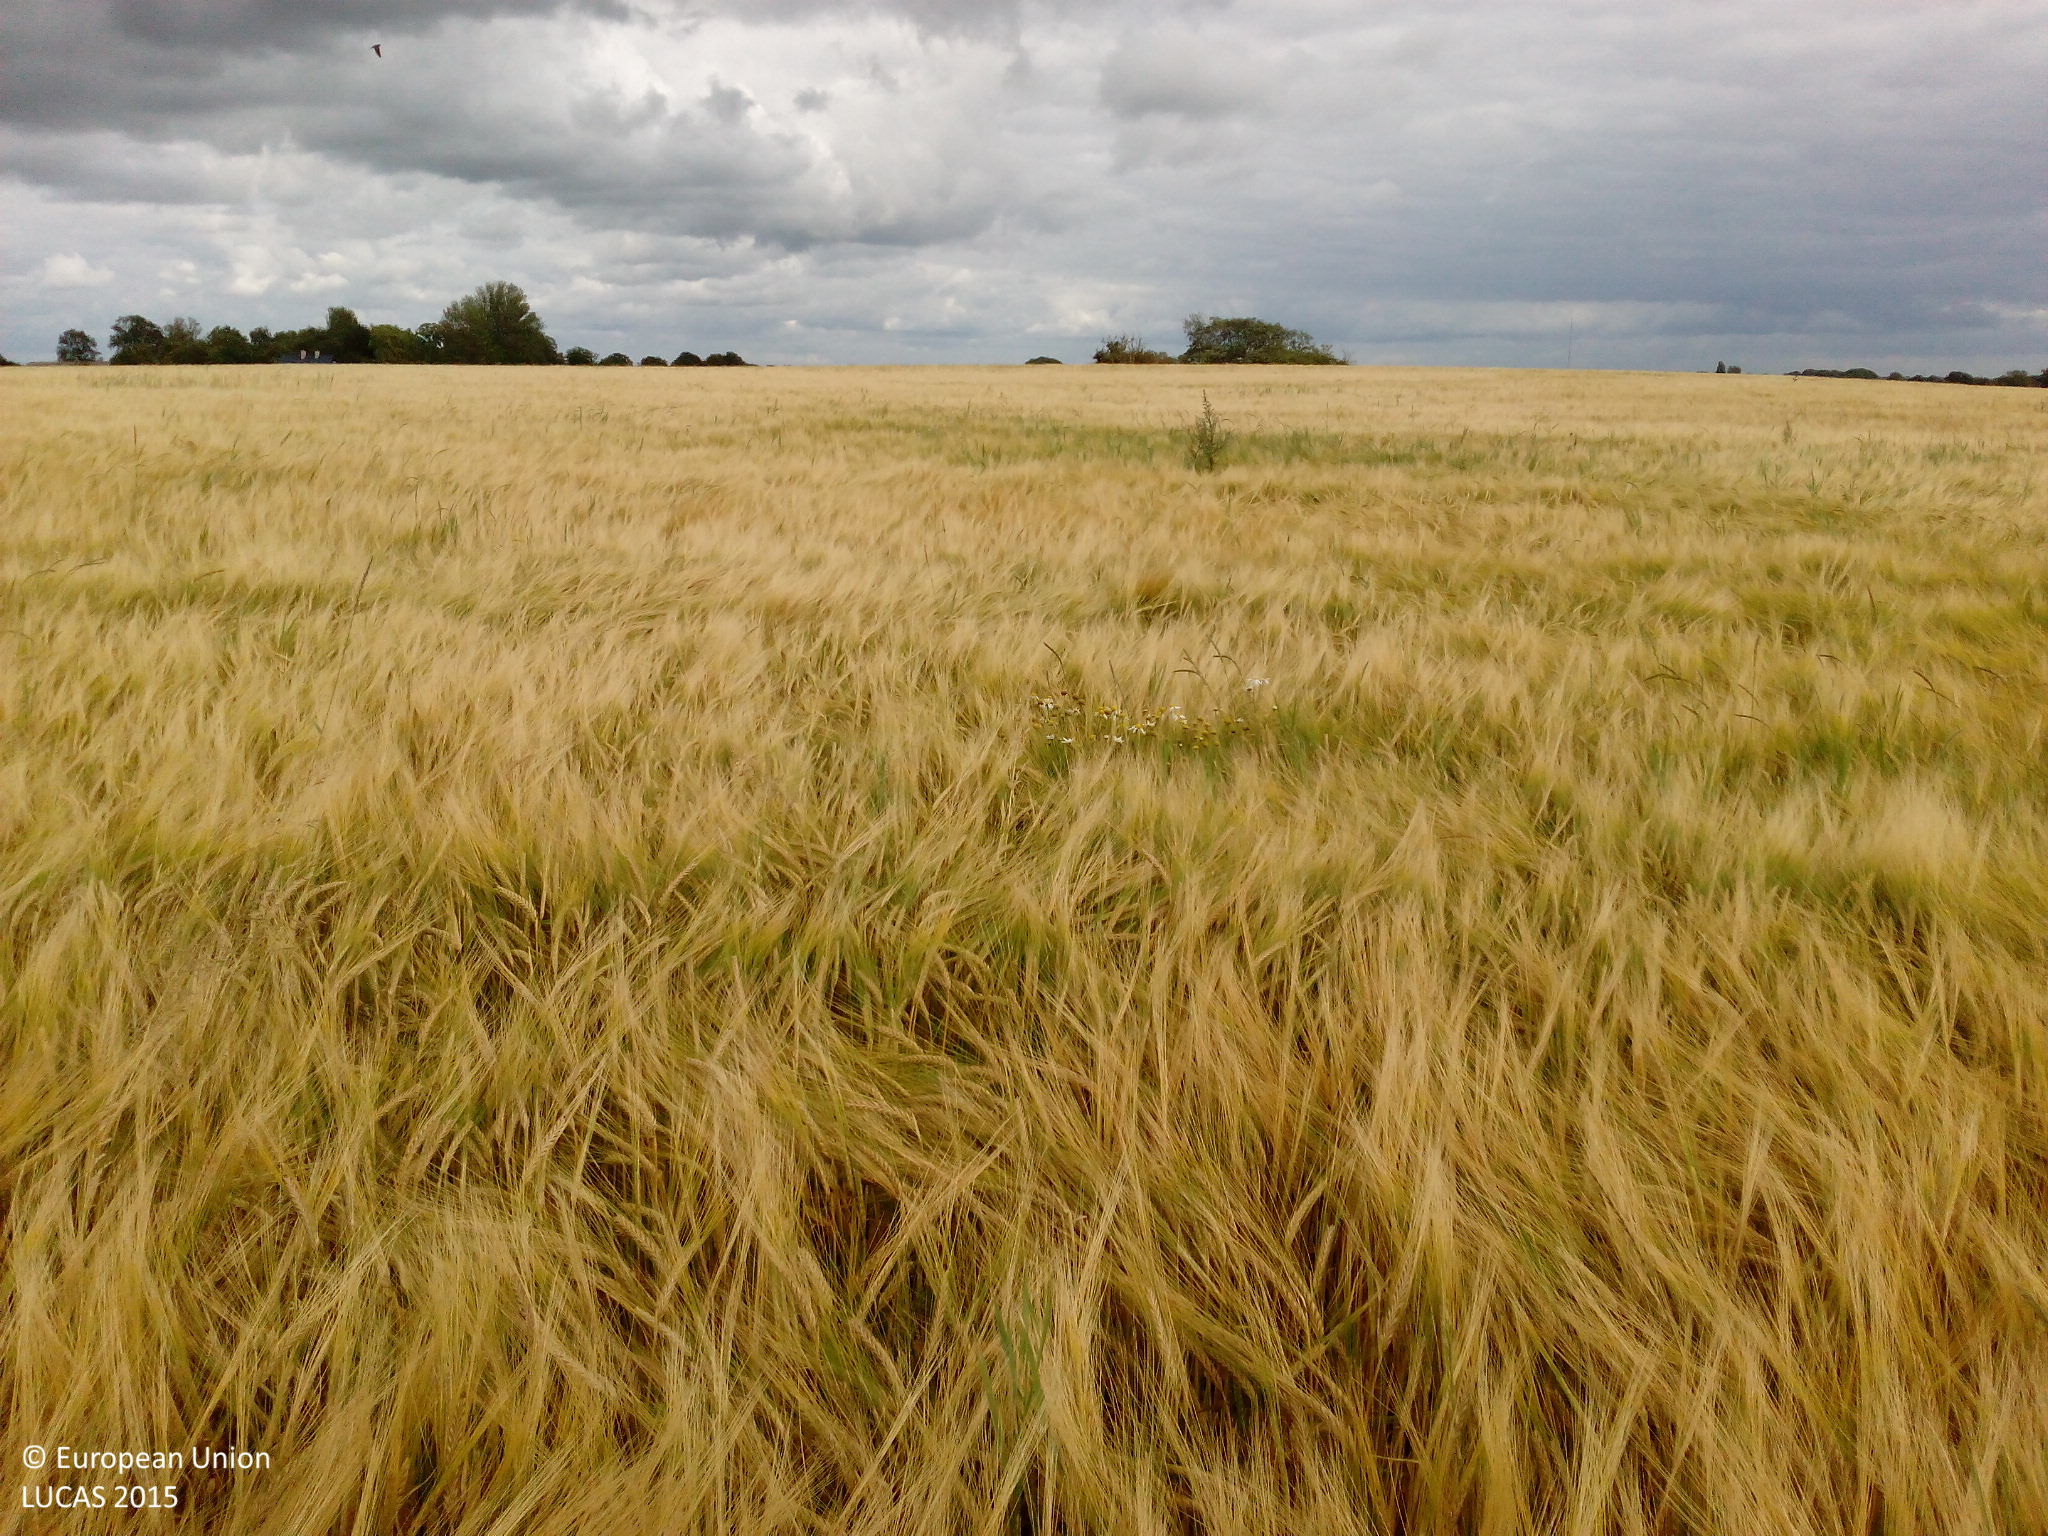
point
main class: Cropland
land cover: Barley
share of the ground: > 75 %
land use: Agriculture (excluding fallow land and kitchen gardens)
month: July
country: DK
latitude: 55.7388
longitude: 12.1165
